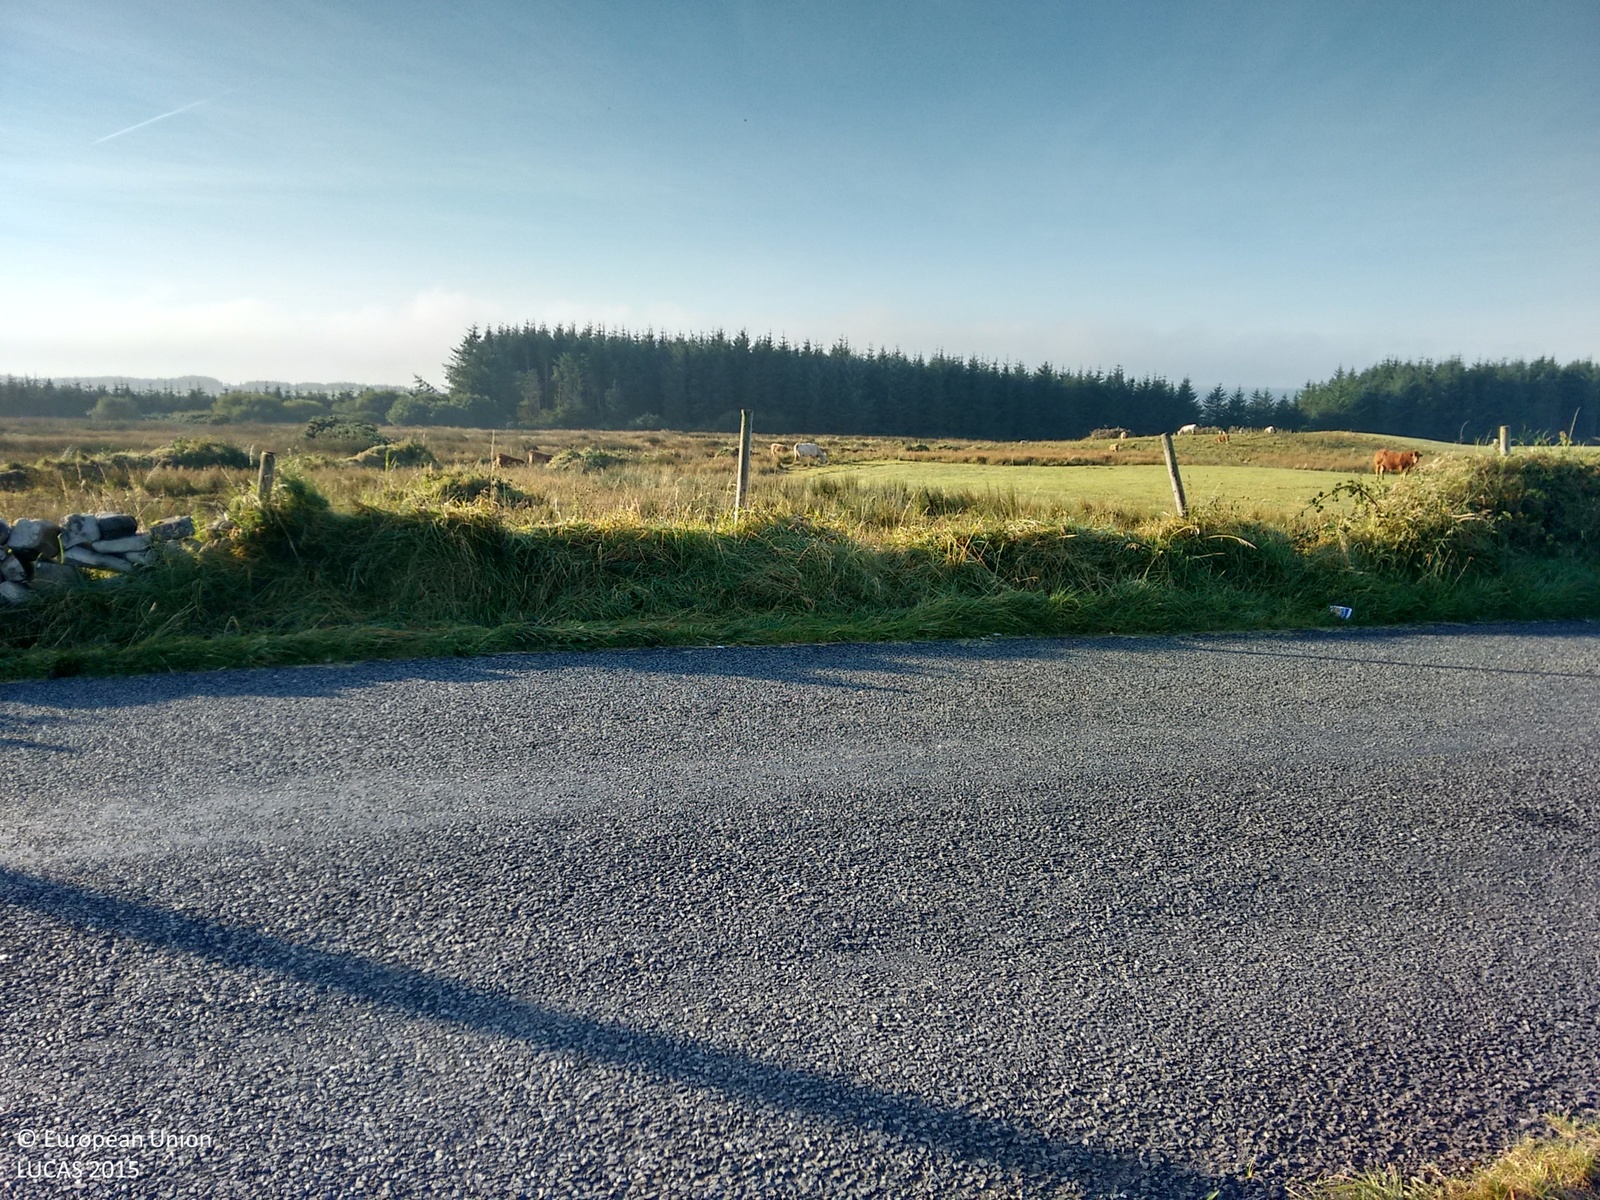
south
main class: Grassland
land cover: Grassland without tree/shrub cover
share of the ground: > 75 %
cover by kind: herbaceous plants 100 %
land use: Agriculture (excluding fallow land and kitchen gardens)
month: September
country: IE
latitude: 53.0266
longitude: -9.3252
